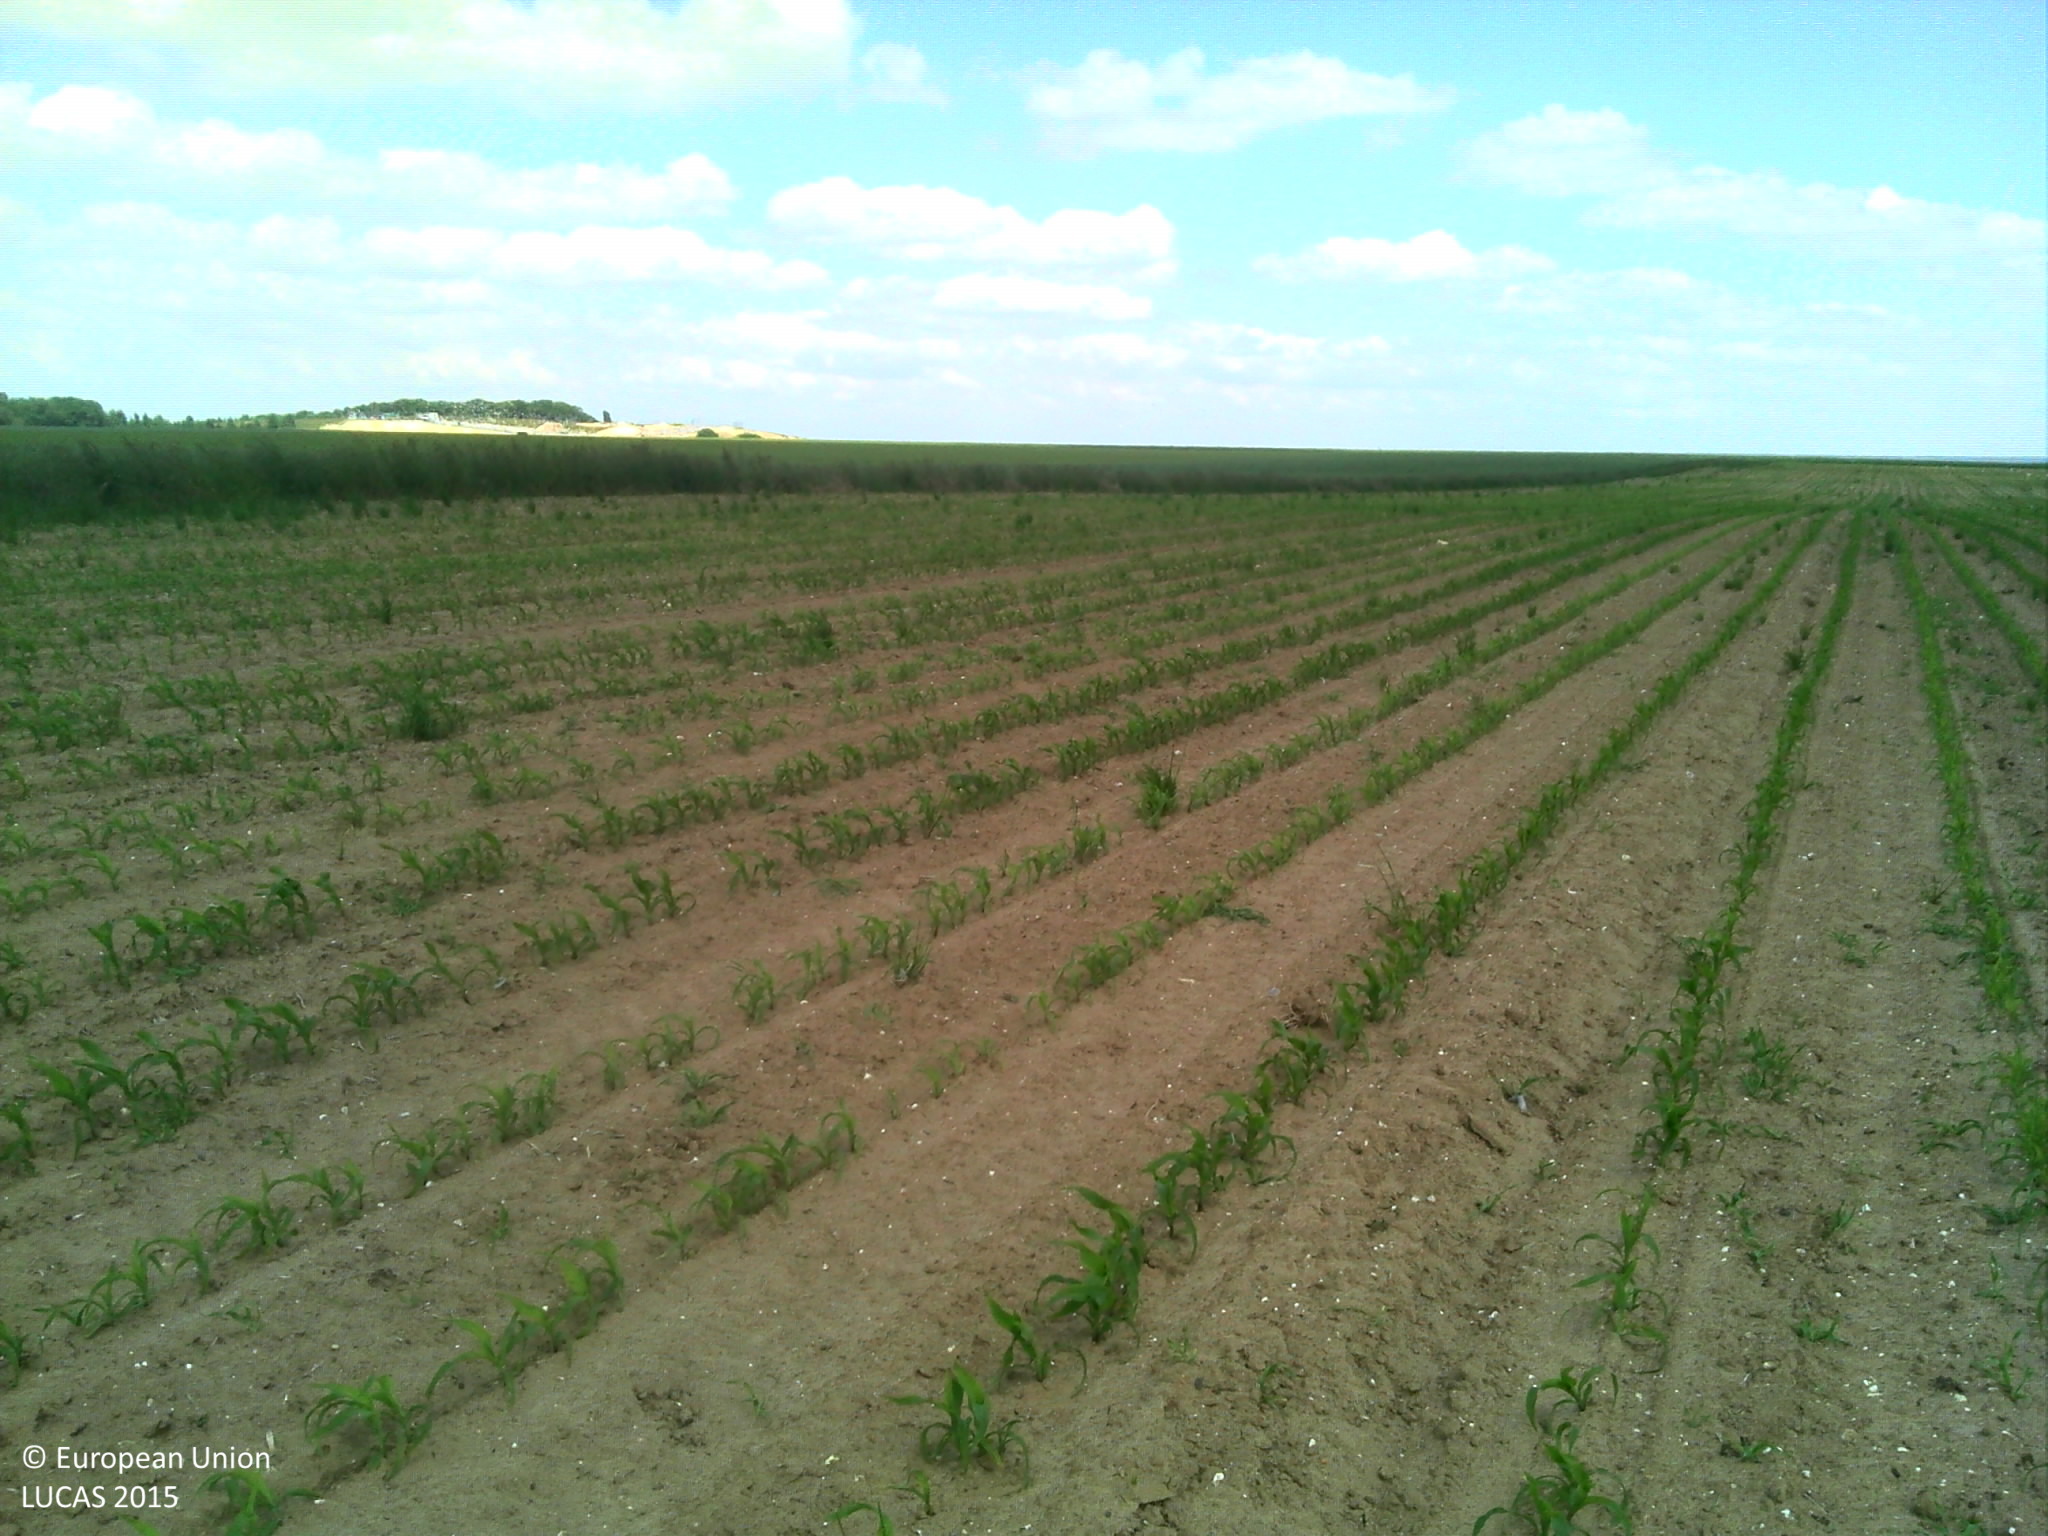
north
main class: Cropland
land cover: Maize
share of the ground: > 75 %
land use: Agriculture (excluding fallow land and kitchen gardens)
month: June
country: FR
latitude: 50.1334
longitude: 1.6863
